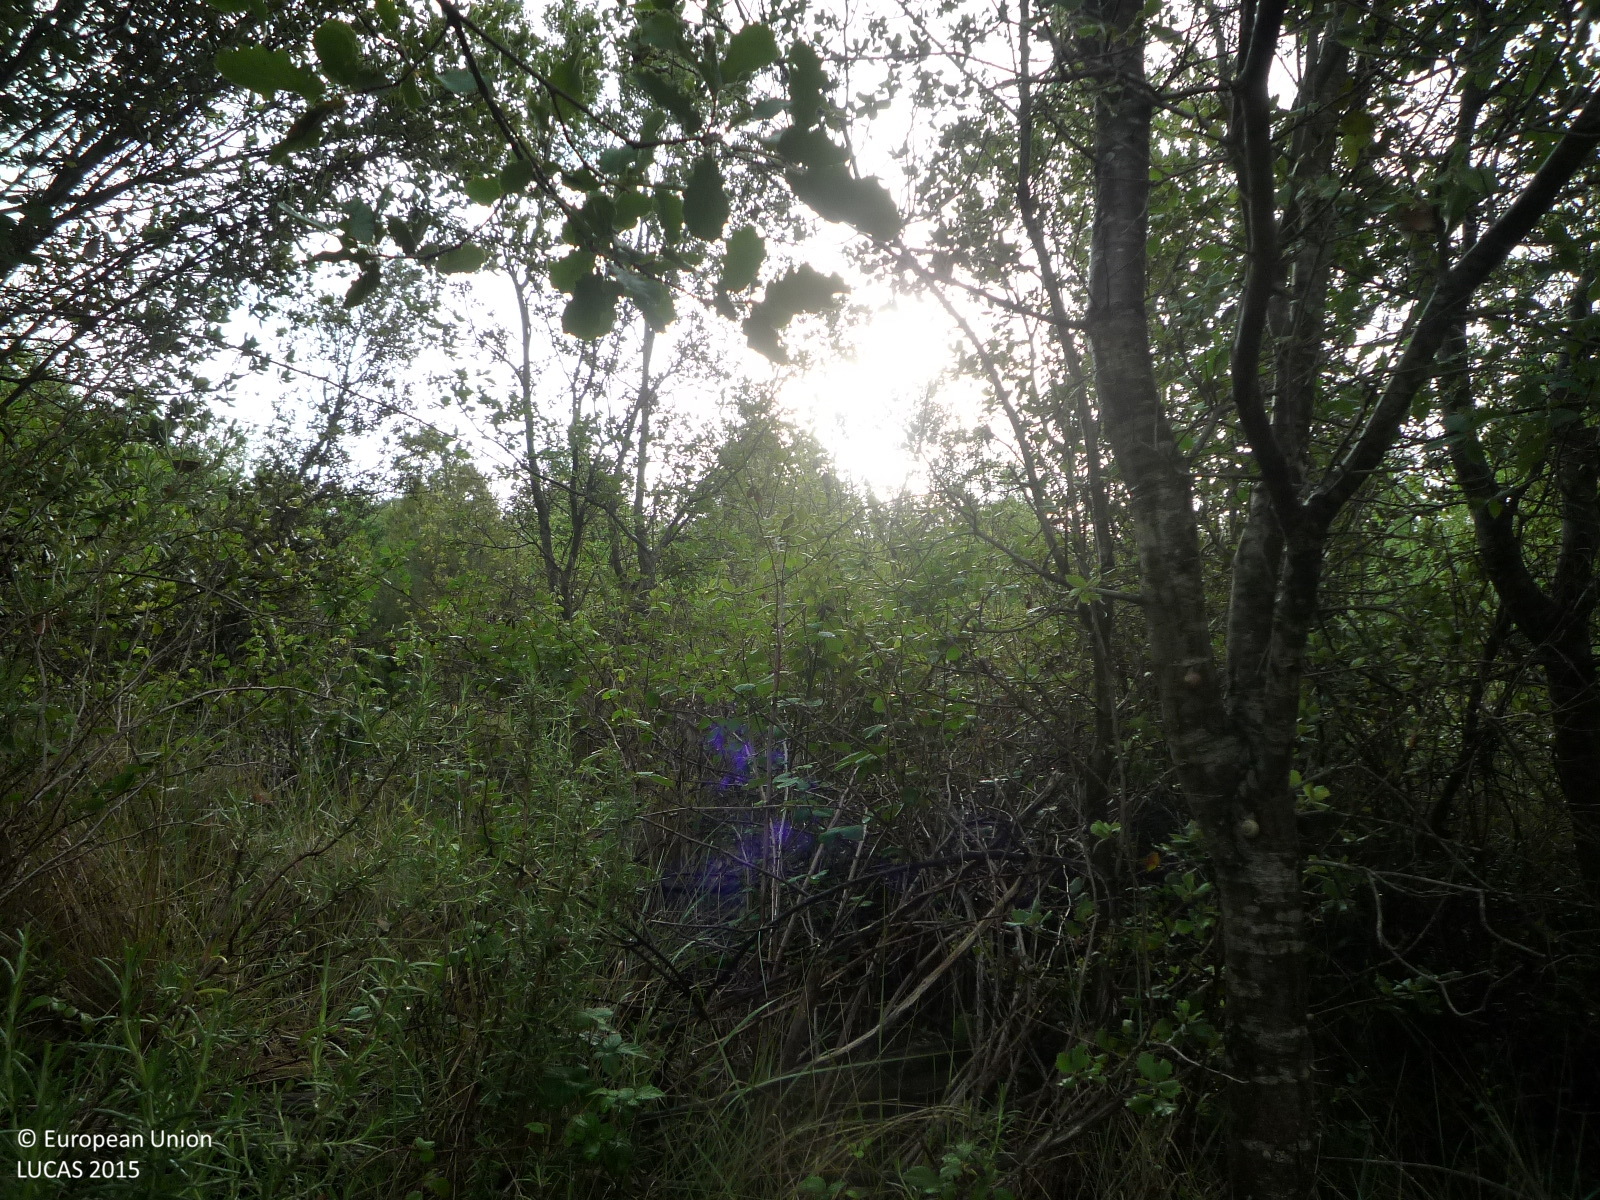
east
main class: Woodland
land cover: Broadleaved woodland
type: broadleaved evergreen forest
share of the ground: > 75 %
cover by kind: broadleaved forest trees 80 %, shrubs 20 %
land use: Semi-natural and natural areas not in use
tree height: < 5 m
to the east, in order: Broadleaved woodland; Rock outcrops; Other mixed woodland; Common wheat; Pine dominated mixed woodland; Fences; Pine dominated coniferous woodland
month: June
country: ES
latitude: 42.0055
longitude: 1.9363
